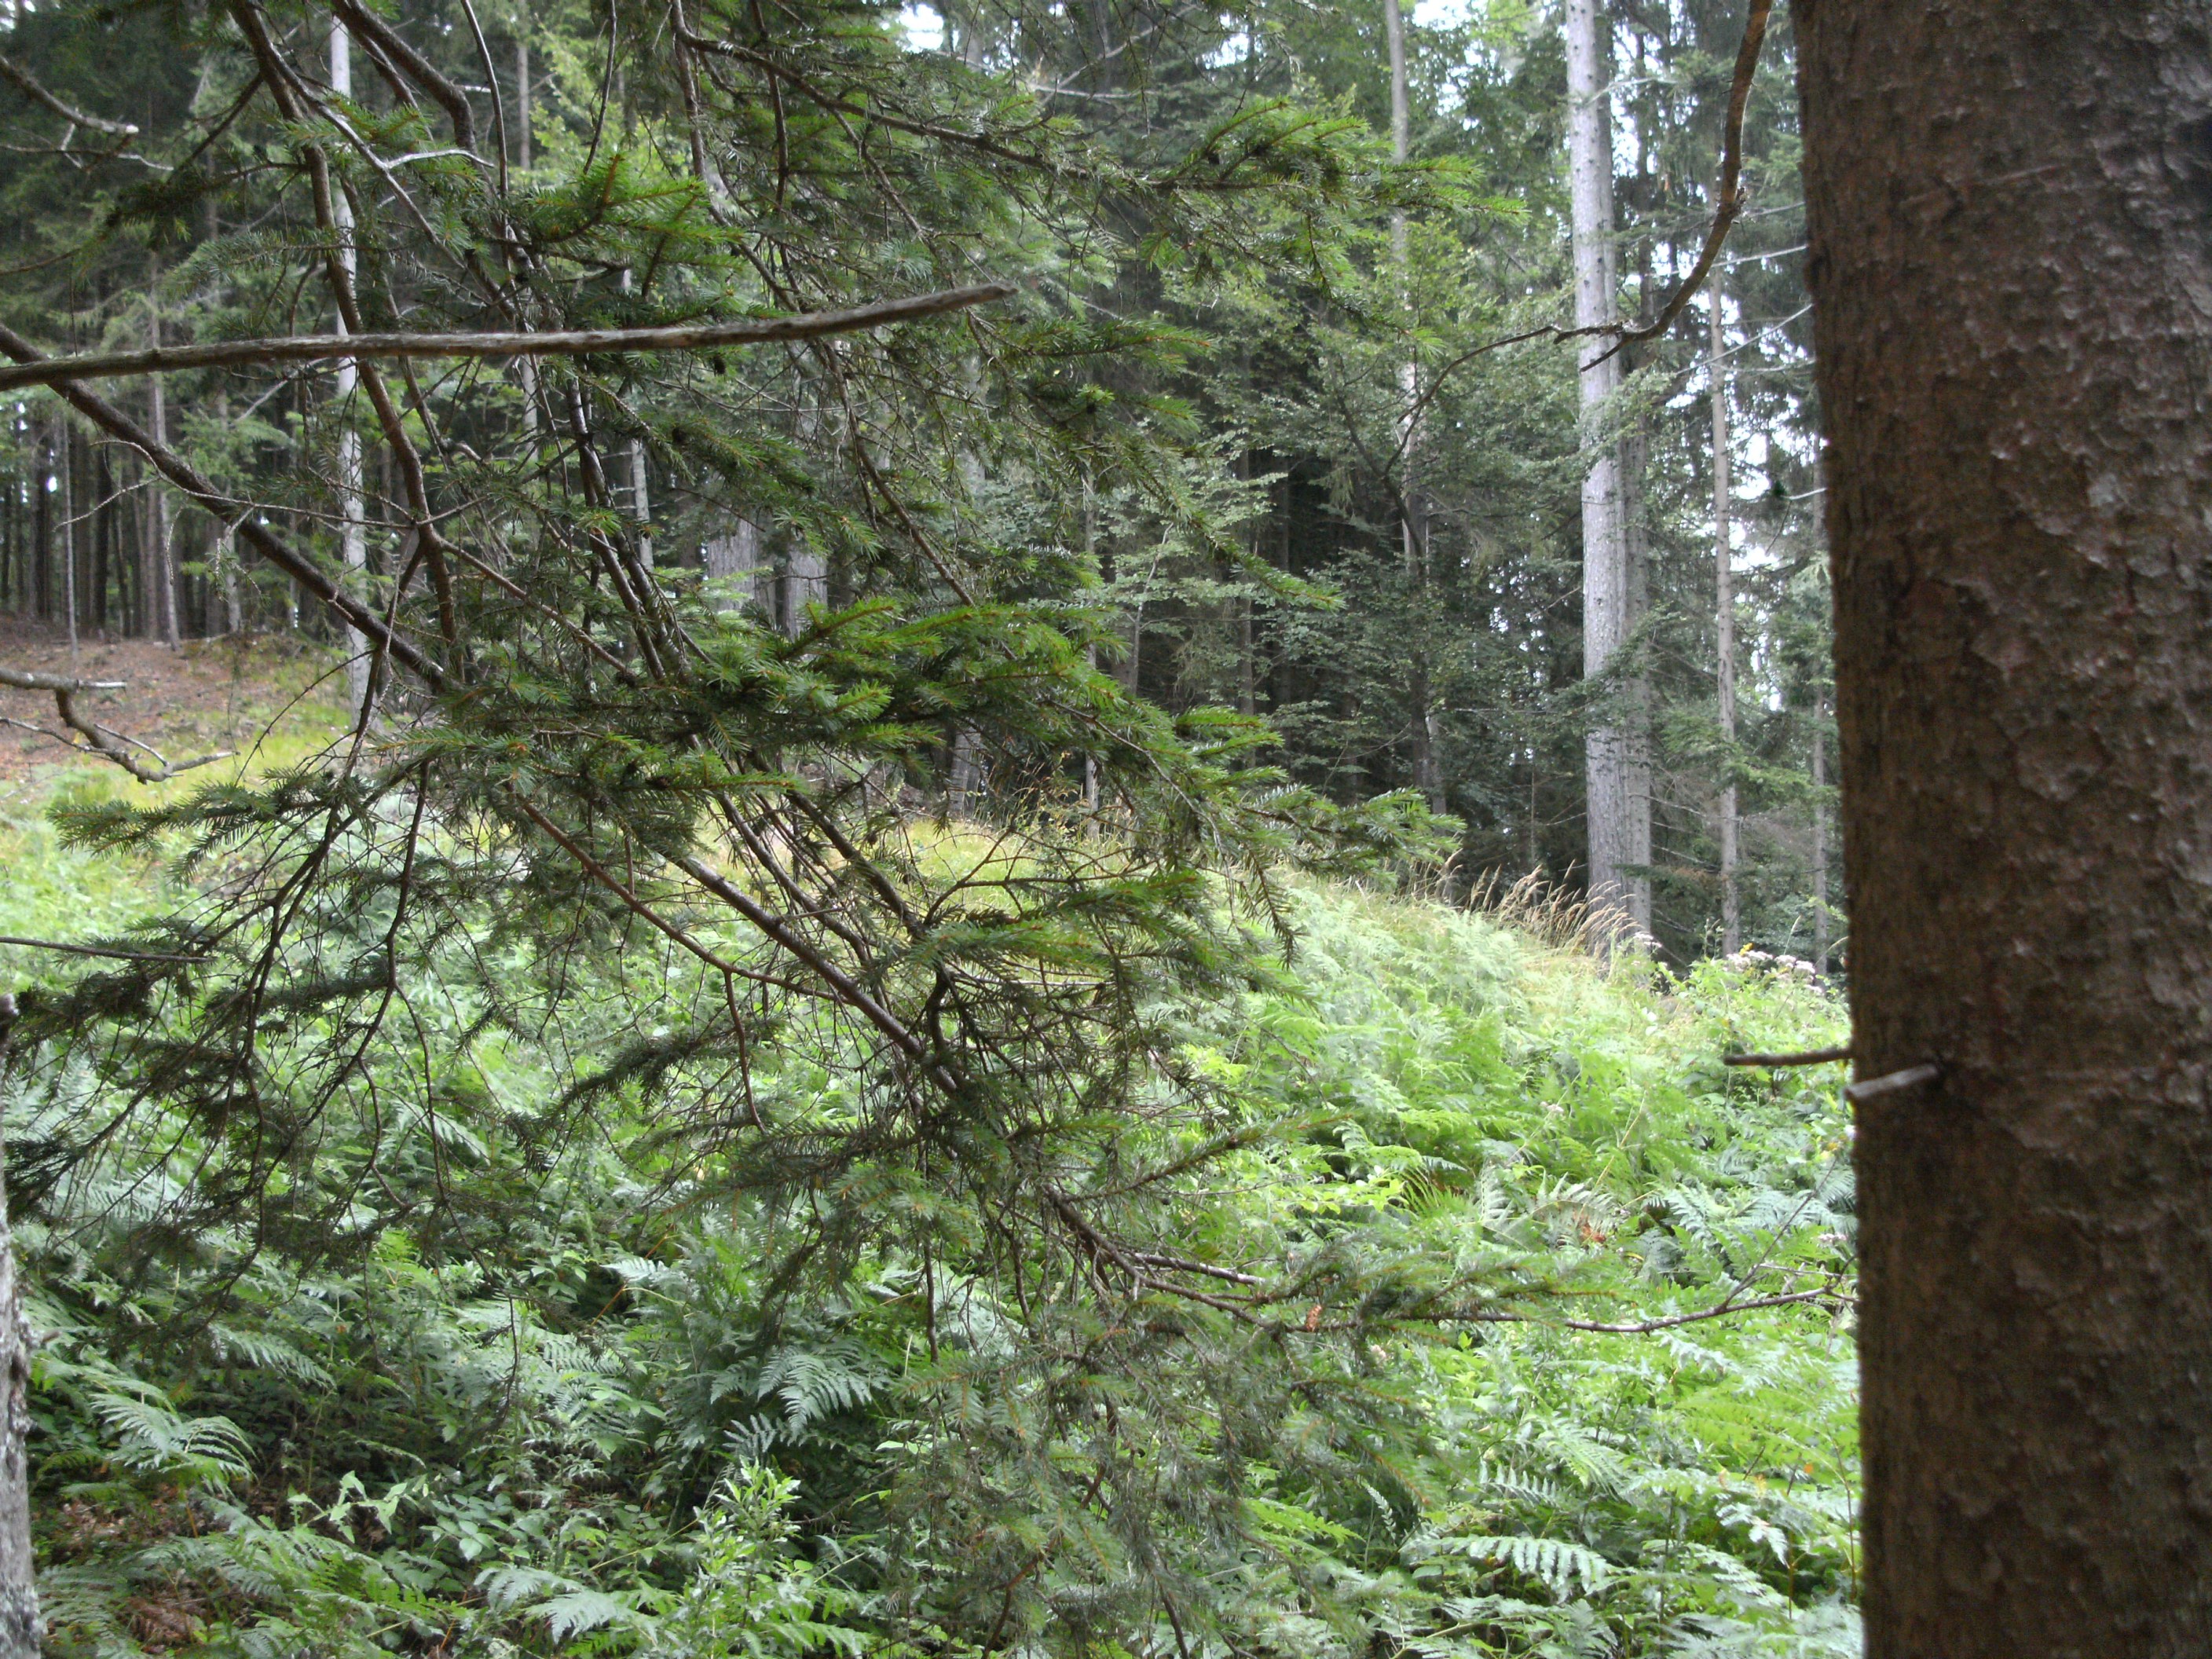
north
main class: Grassland
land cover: Spontaneously vegetated surfaces
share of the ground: > 75 %
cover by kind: herbaceous plants 100 %
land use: Forestry
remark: Clear cut
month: July
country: AT
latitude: 46.5295
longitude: 14.4431
